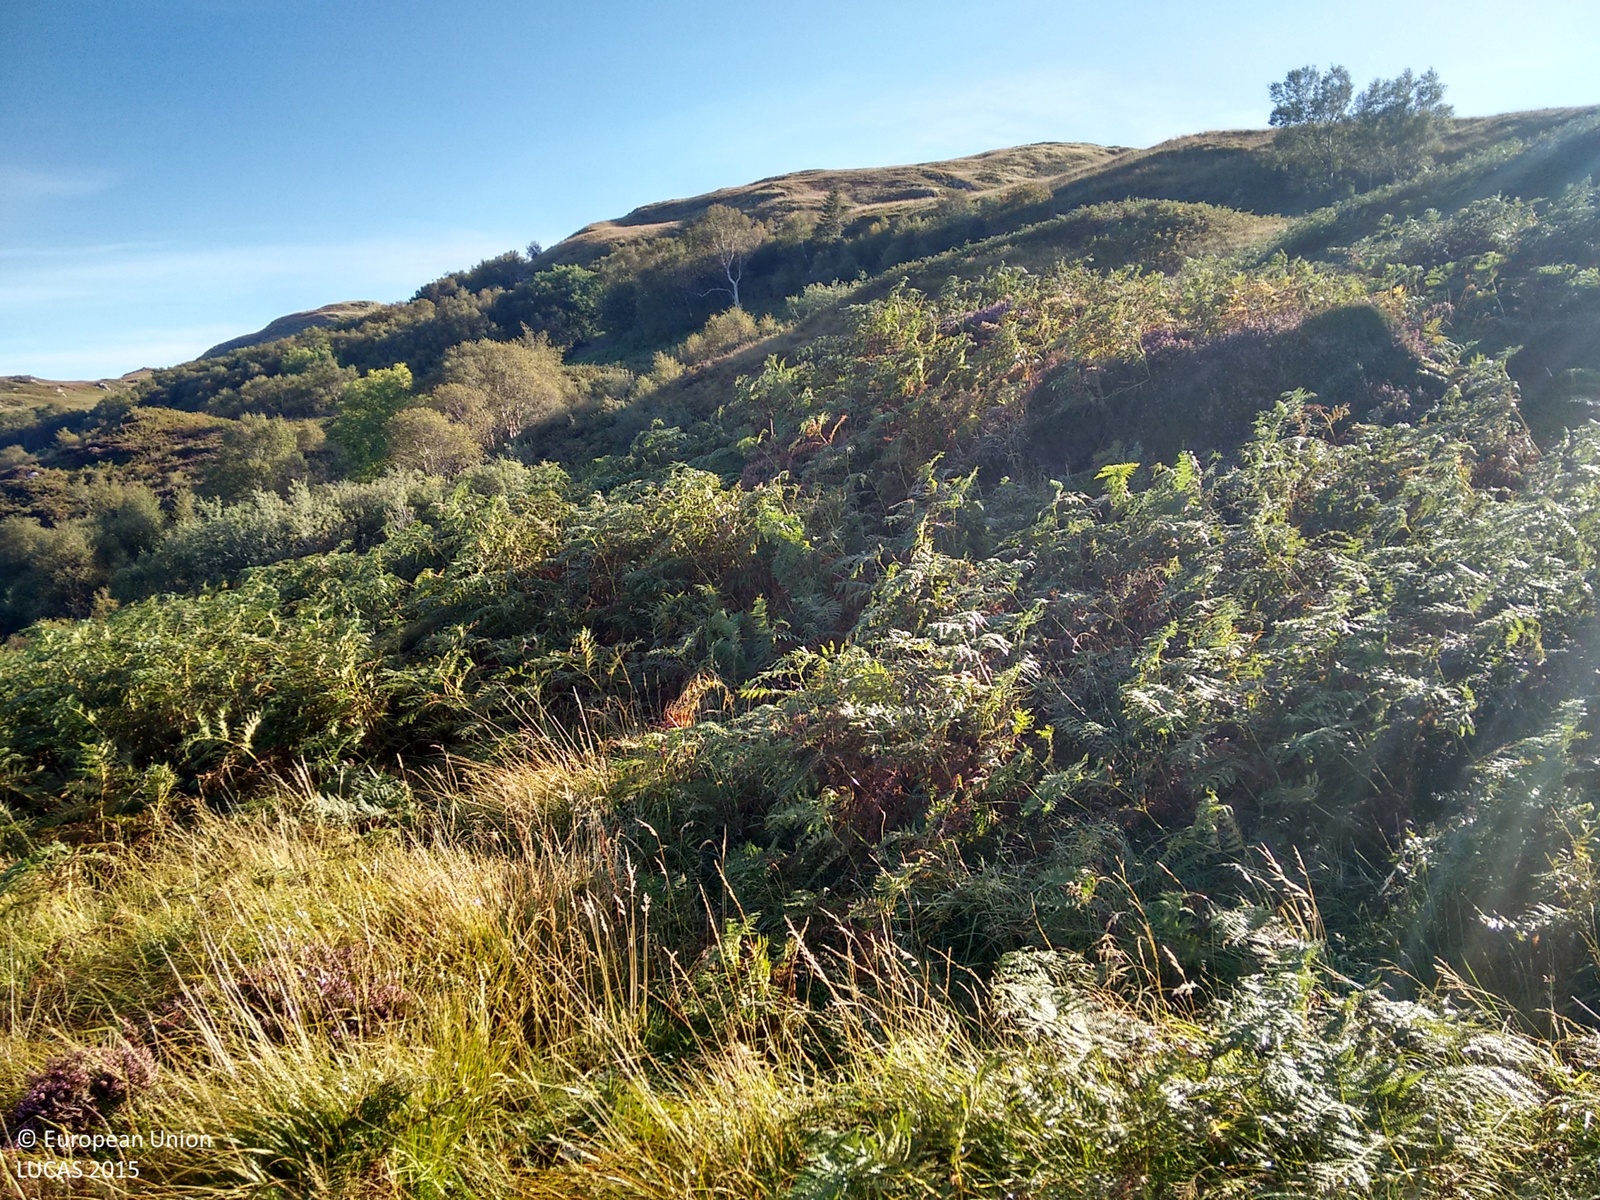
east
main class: Shrubland
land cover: Shrubland without tree cover
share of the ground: > 75 %
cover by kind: shrubs 75 %, herbaceous plants 25 %
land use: Semi-natural and natural areas not in use
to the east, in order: Shrubland without tree cover; Shrubland with sparse tree cover; Broadleaved woodland; Shrubland without tree cover; Grassland without tree/shrub cover
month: September
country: GB
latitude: 57.2044
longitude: -5.6308
